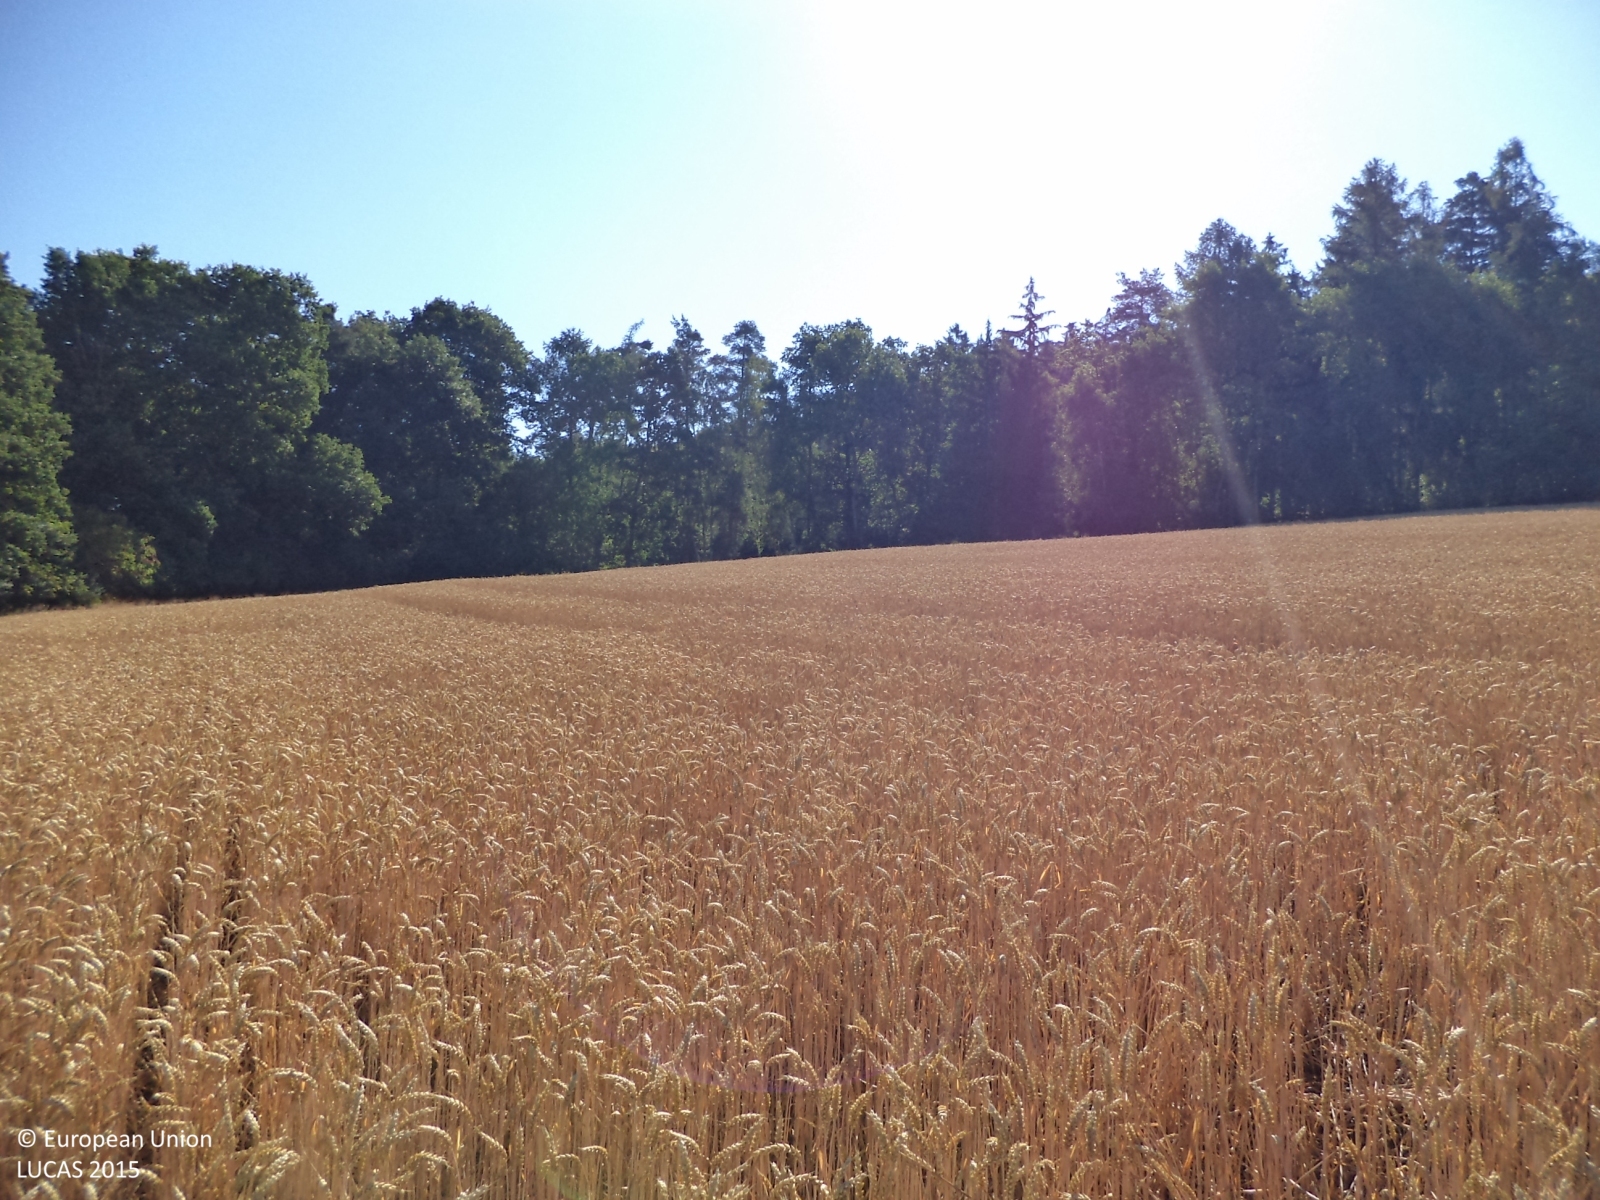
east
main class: Cropland
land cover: Common wheat
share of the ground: > 75 %
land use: Agriculture (excluding fallow land and kitchen gardens)
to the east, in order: Common wheat; Spruce dominated mixed woodland; Tracks; Fences; Spruce dominated coniferous woodland; Fences; Tracks; Spruce dominated coniferous woodland
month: July
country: CZ
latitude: 49.7011
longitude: 14.4522
